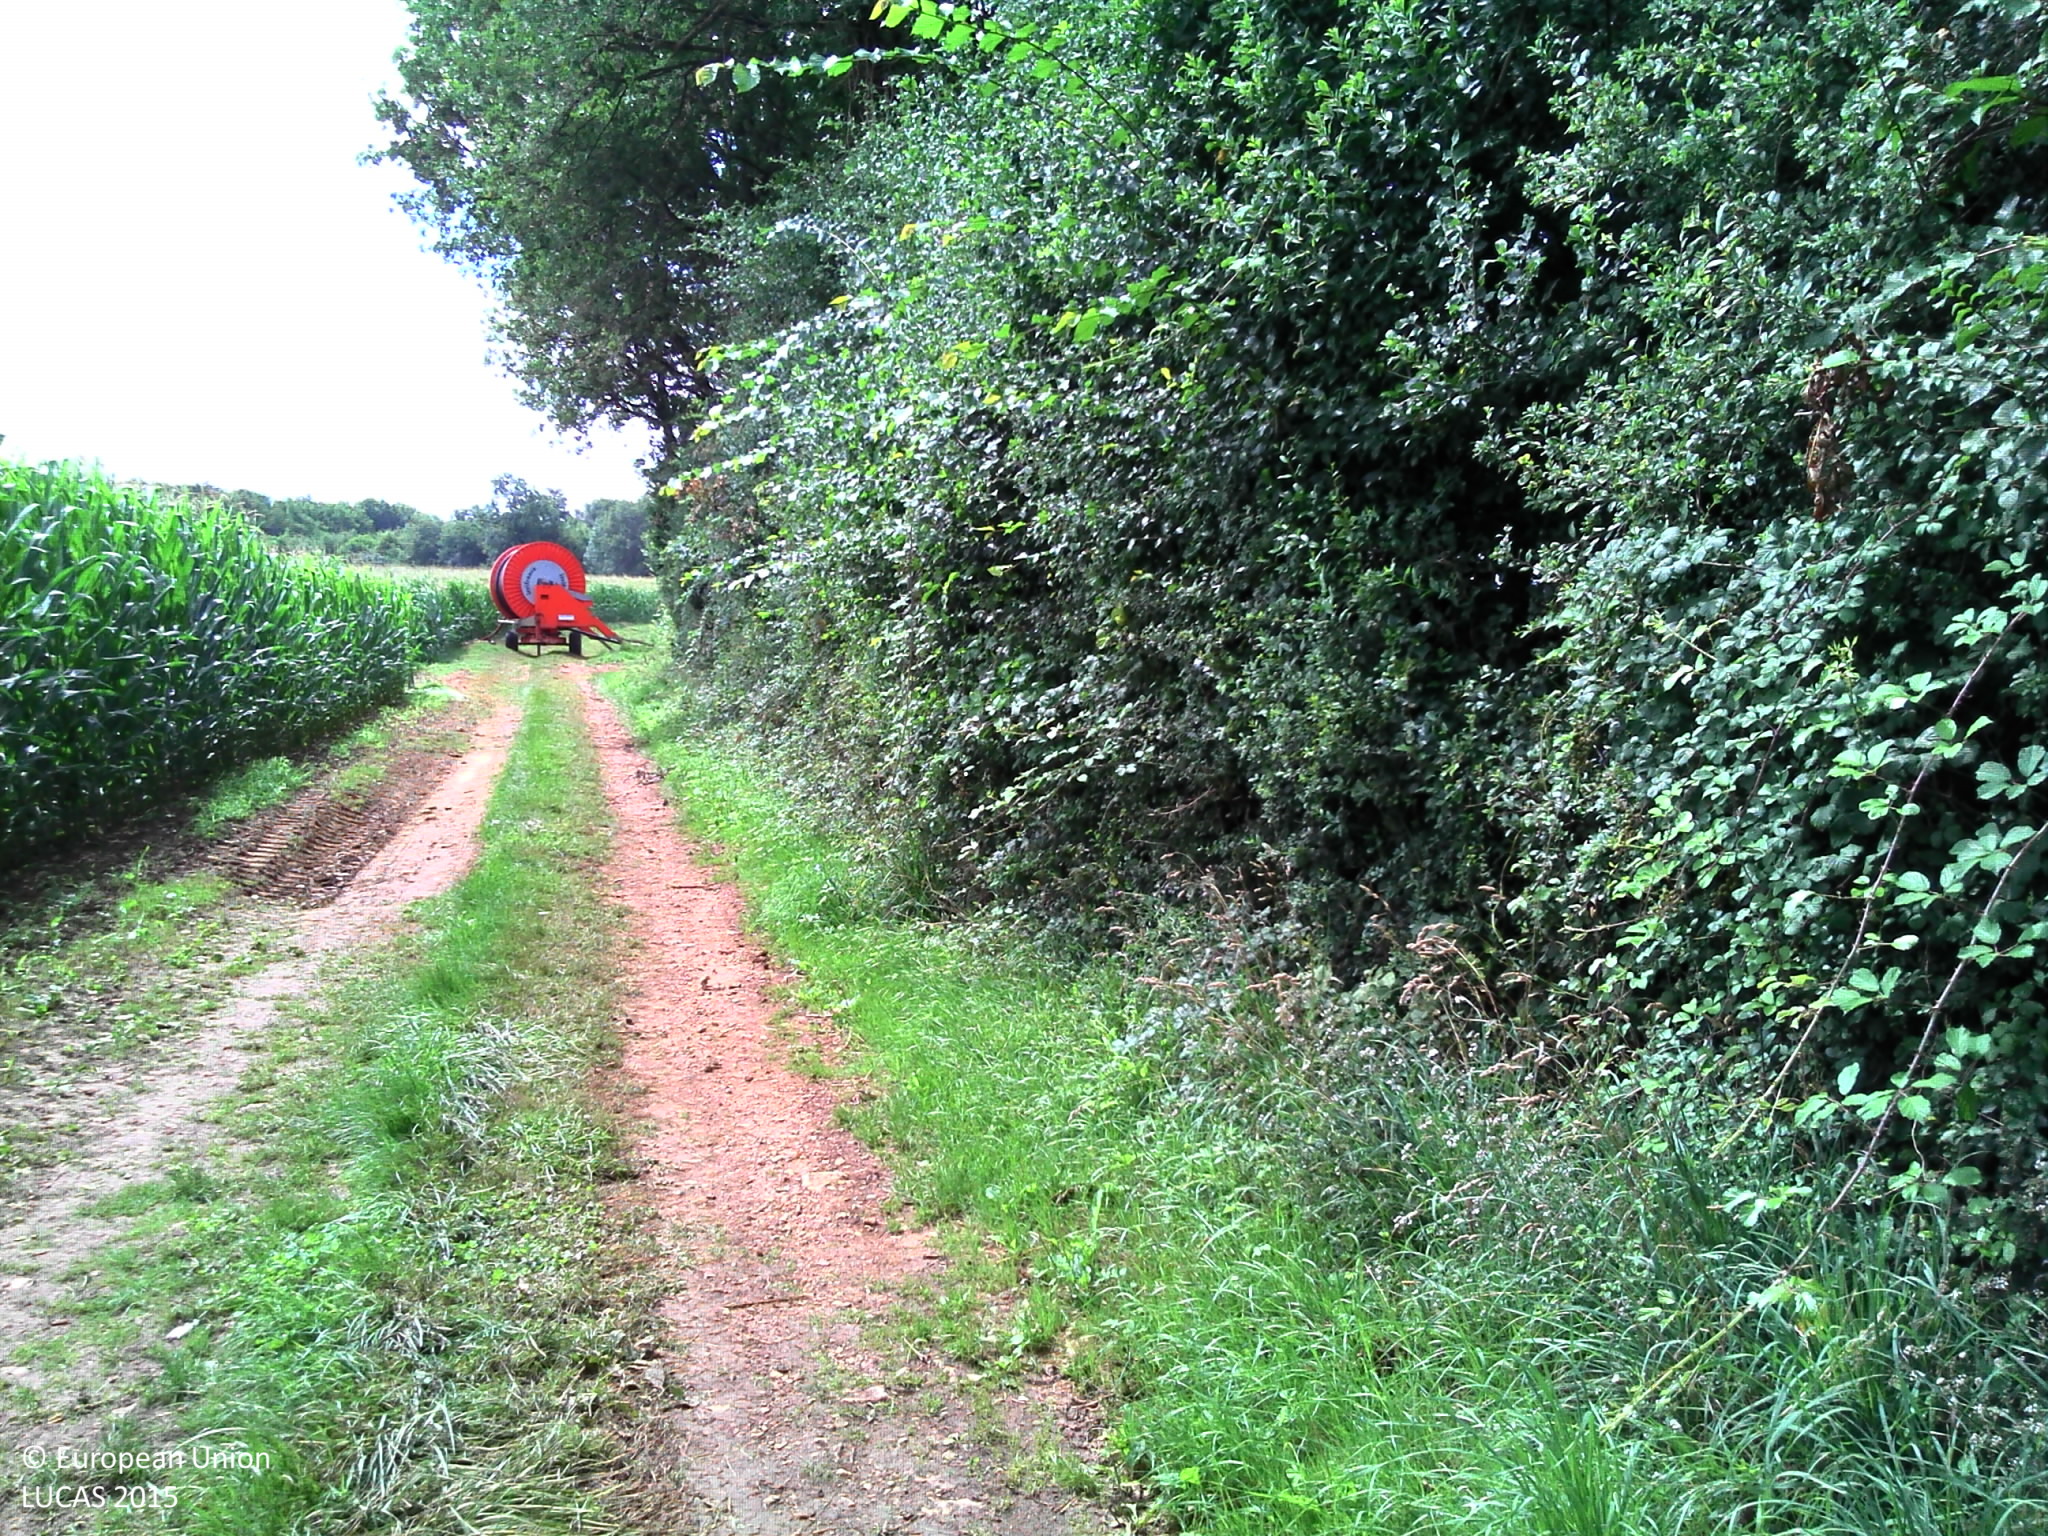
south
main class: Cropland
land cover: Maize
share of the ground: > 75 %
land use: Agriculture (excluding fallow land and kitchen gardens)
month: July
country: FR
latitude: 46.3781
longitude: 0.2693
